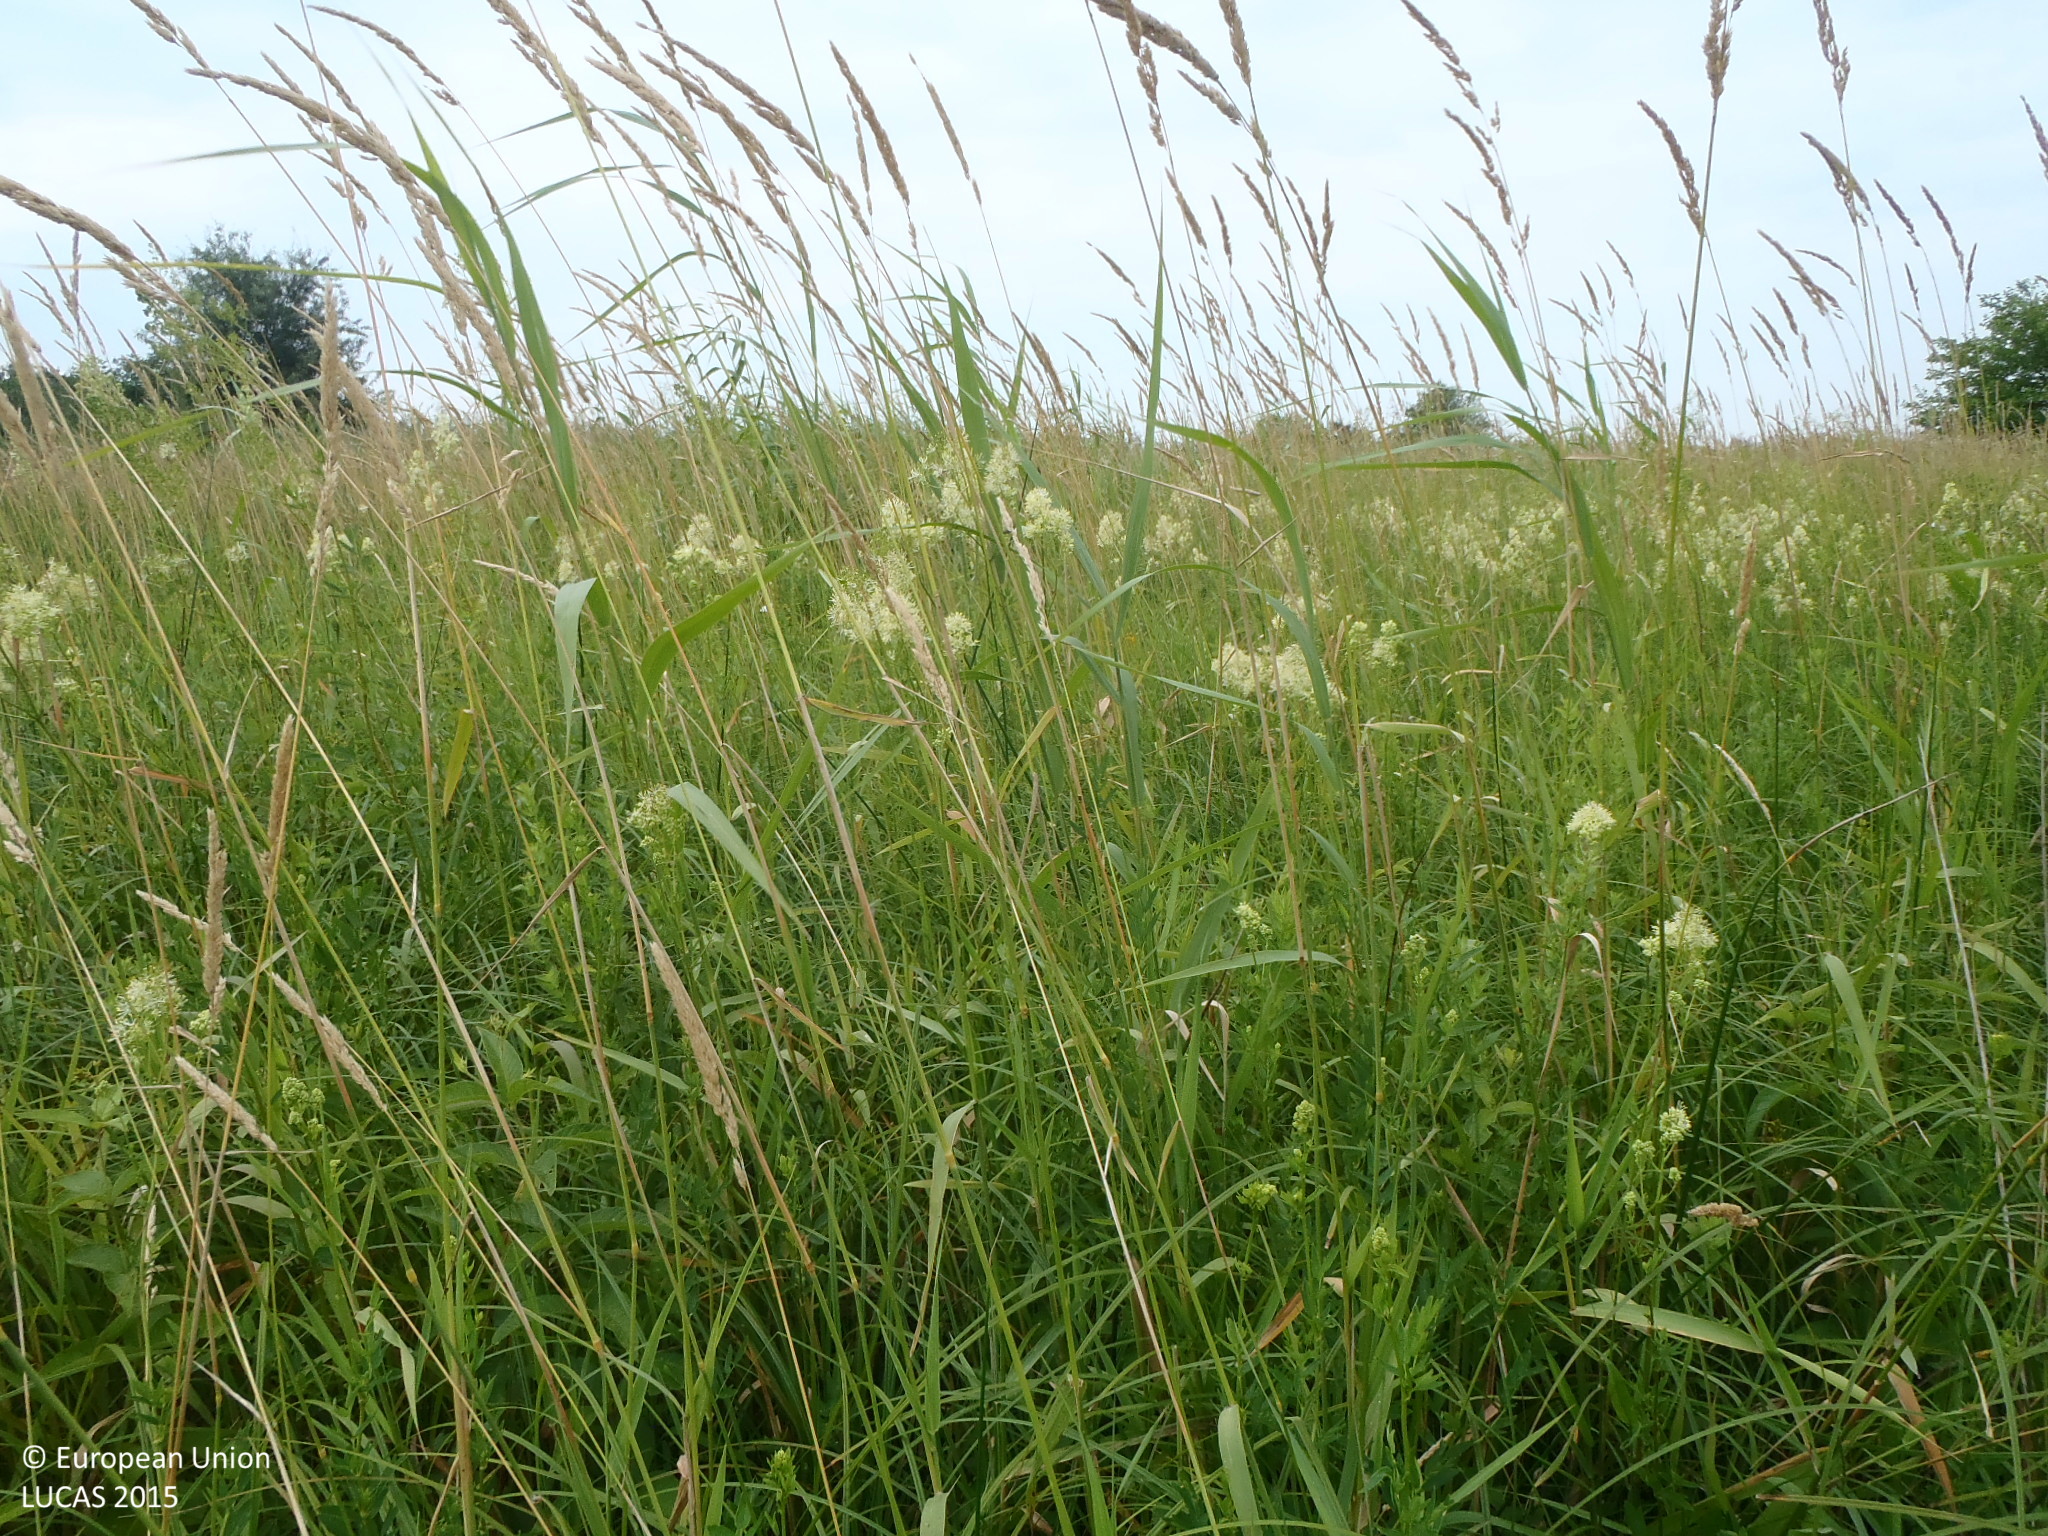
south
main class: Grassland
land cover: Spontaneously vegetated surfaces
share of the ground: > 75 %
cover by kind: herbaceous plants 95 %, shrubs 5 %
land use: Semi-natural and natural areas not in use
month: July
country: BG
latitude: 44.0016
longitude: 26.3312
